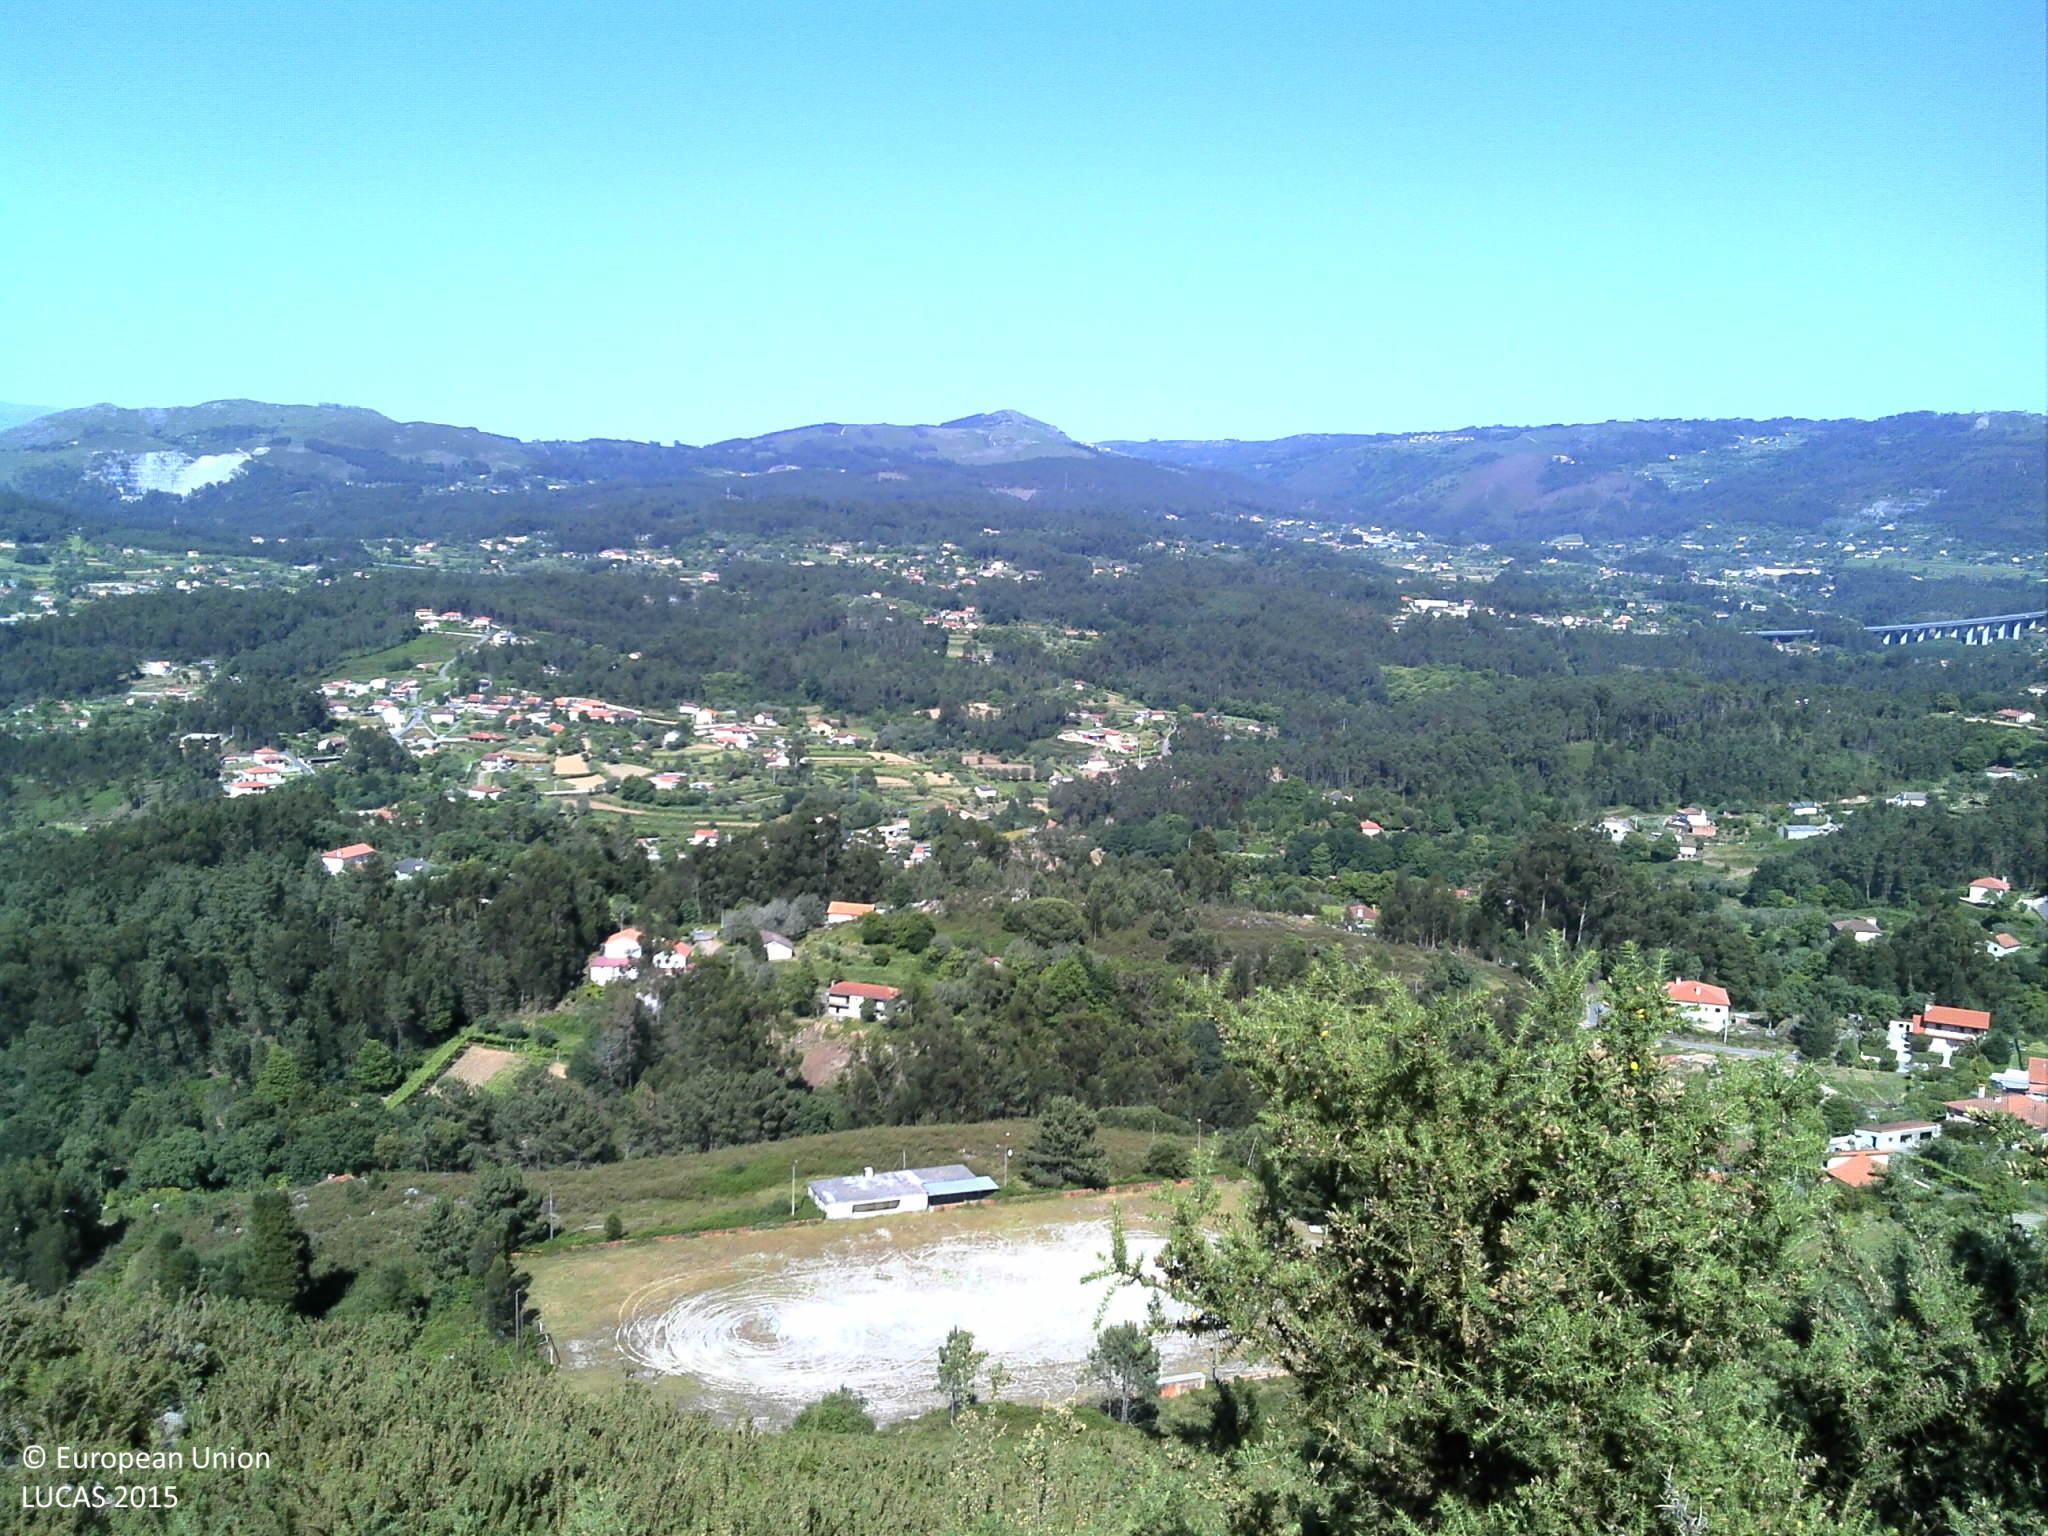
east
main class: Shrubland
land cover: Shrubland without tree cover
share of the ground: > 75 %
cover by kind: shrubs 80 %, herbaceous plants 15 %, unconsolidated bare surface 5 %
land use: Semi-natural and natural areas not in use
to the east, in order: Shrubland without tree cover; Tracks; Shrubland without tree cover; Tracks; Shrubland without tree cover
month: May
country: PT
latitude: 41.7281
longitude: -8.5911
